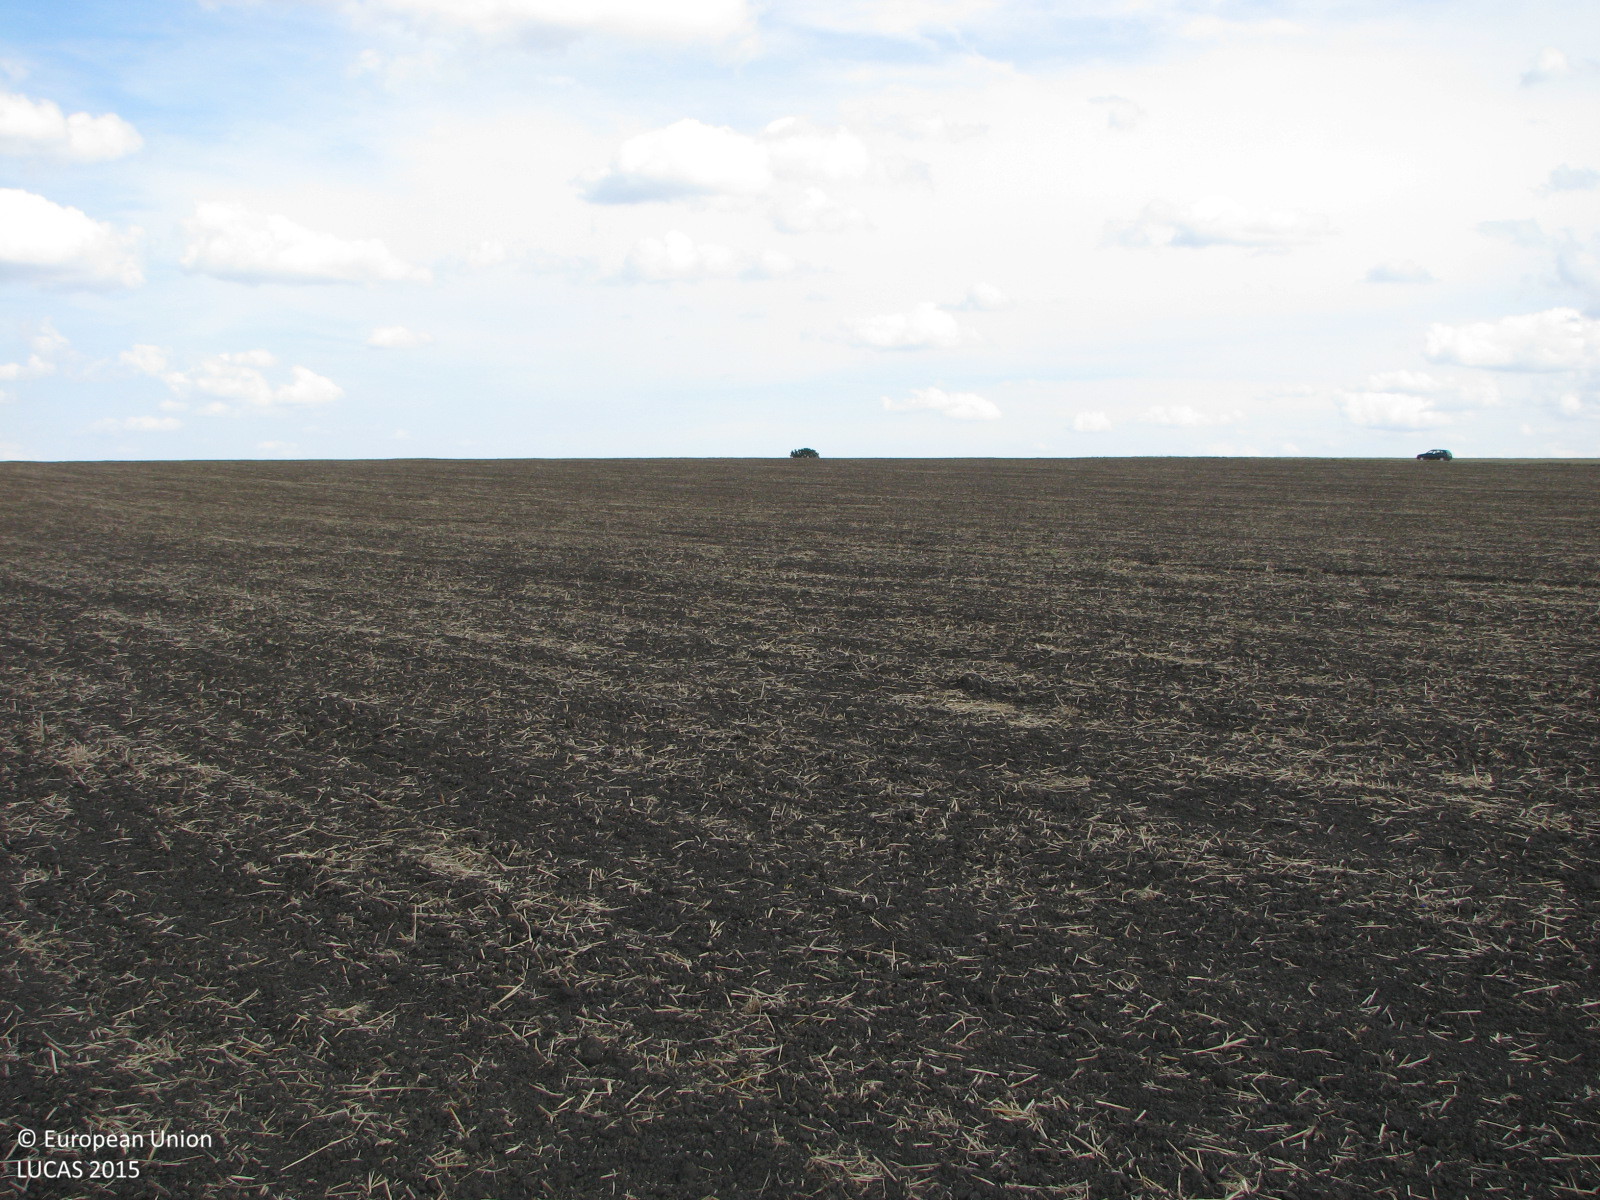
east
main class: Cropland
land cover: Common wheat
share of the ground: < 10 %
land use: Agriculture (excluding fallow land and kitchen gardens)
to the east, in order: Common wheat
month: September
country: BG
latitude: 42.5329
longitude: 26.7667
